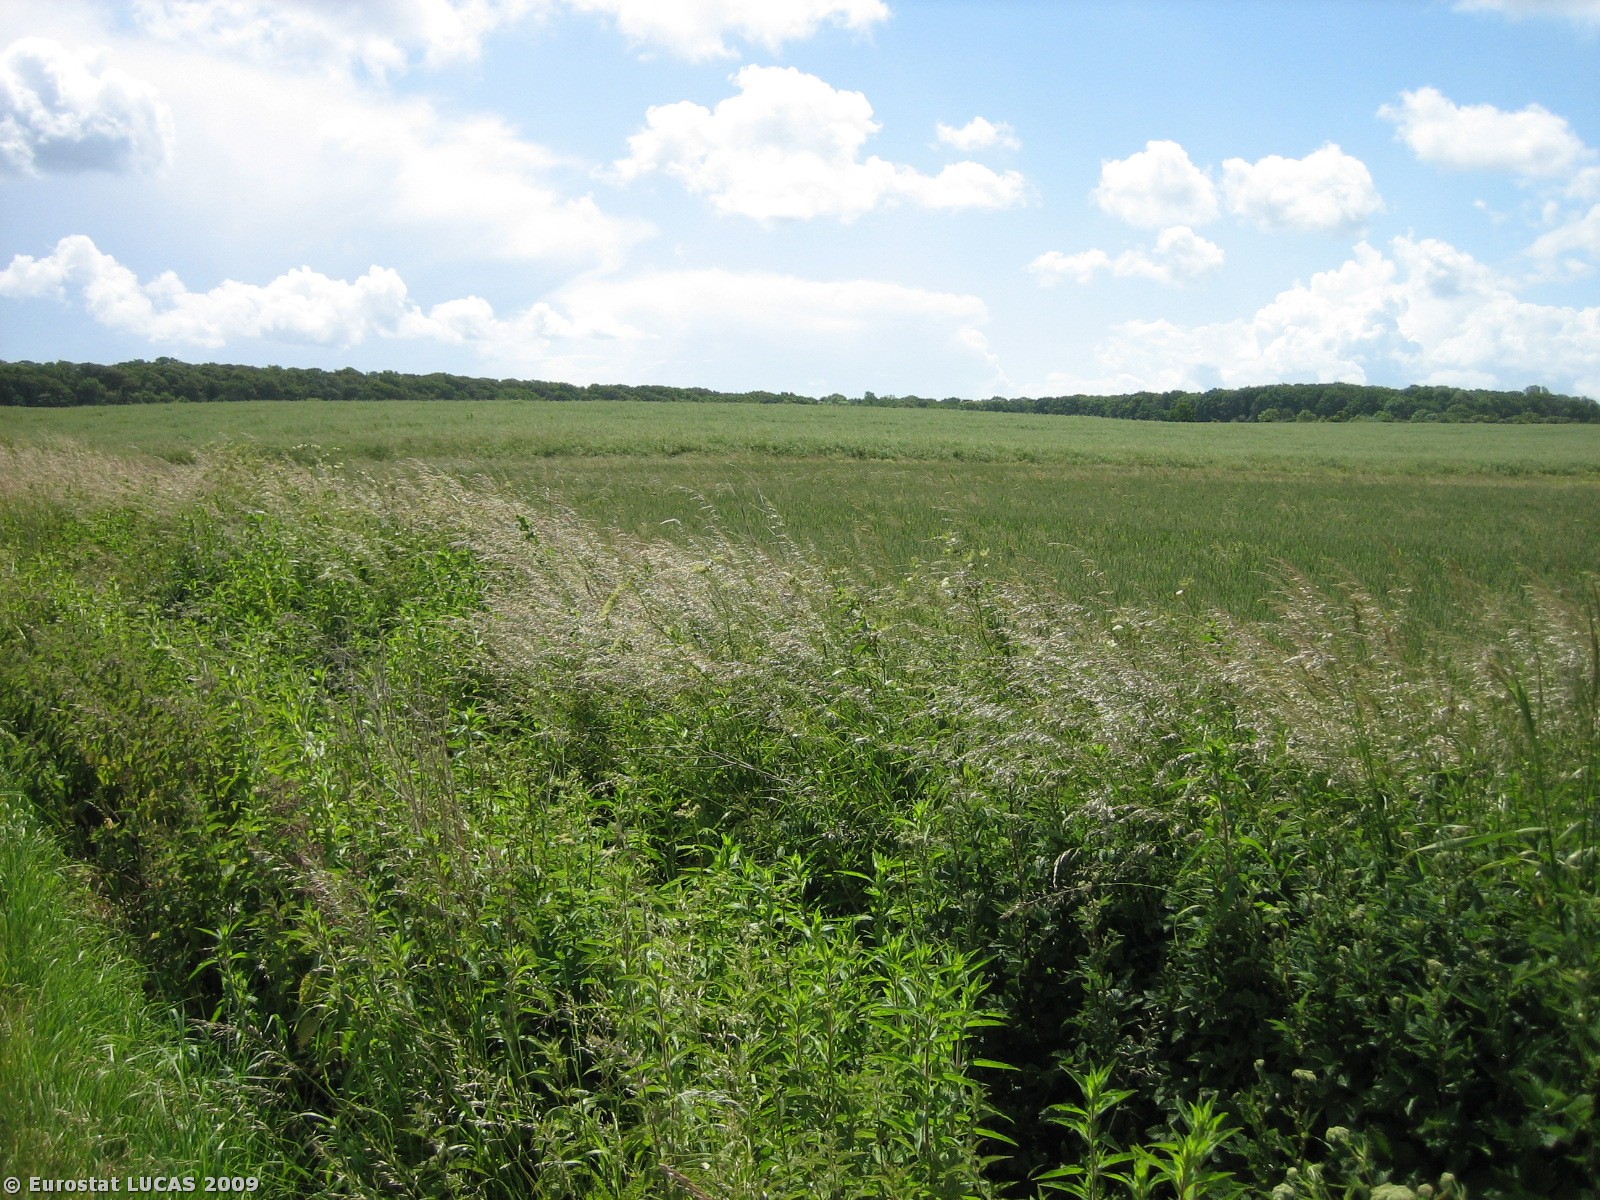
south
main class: Cropland
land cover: Common wheat
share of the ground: > 75 %
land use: Agriculture (excluding fallow land and kitchen gardens)
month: June
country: DK
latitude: 55.6124
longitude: 9.7938
